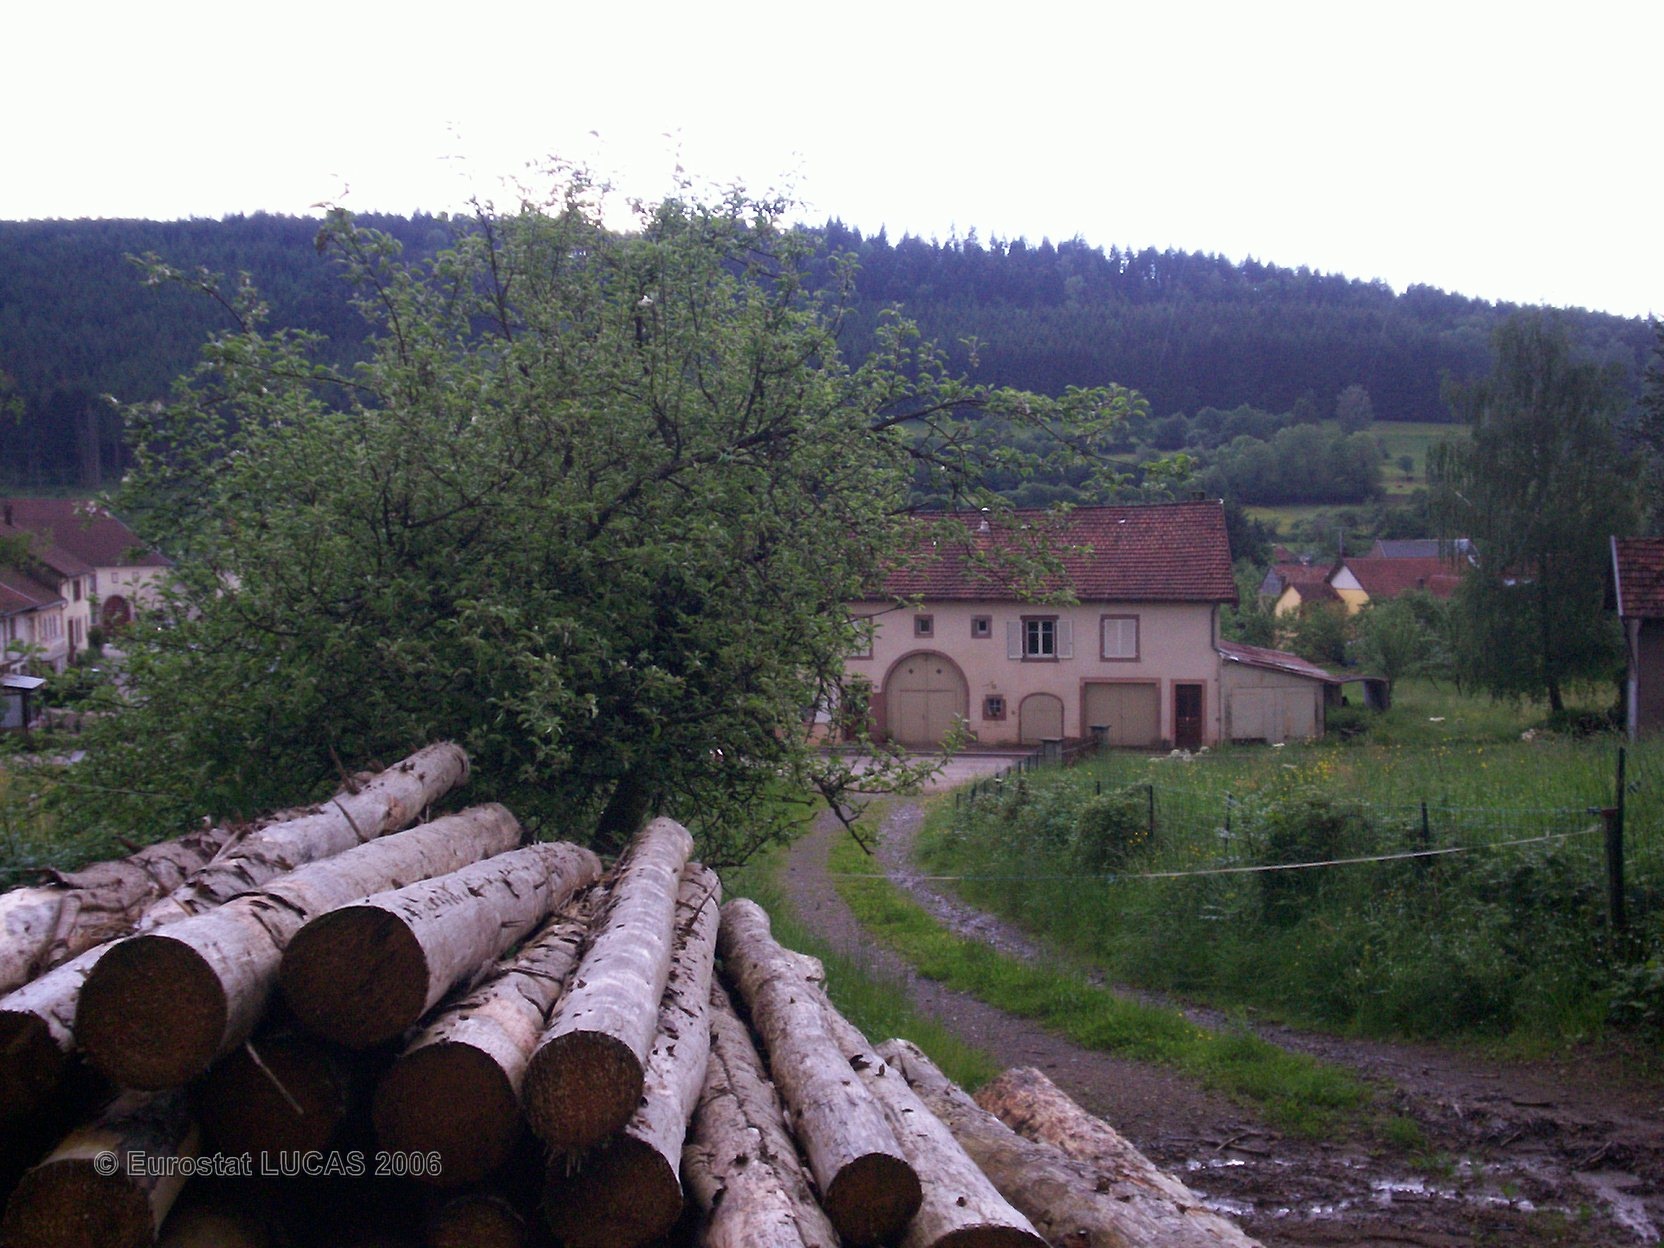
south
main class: Grassland
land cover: Grassland without tree/shrub cover
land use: Agriculture (excluding fallow land and kitchen gardens)
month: May
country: FR
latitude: 48.2935
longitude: 7.1029
